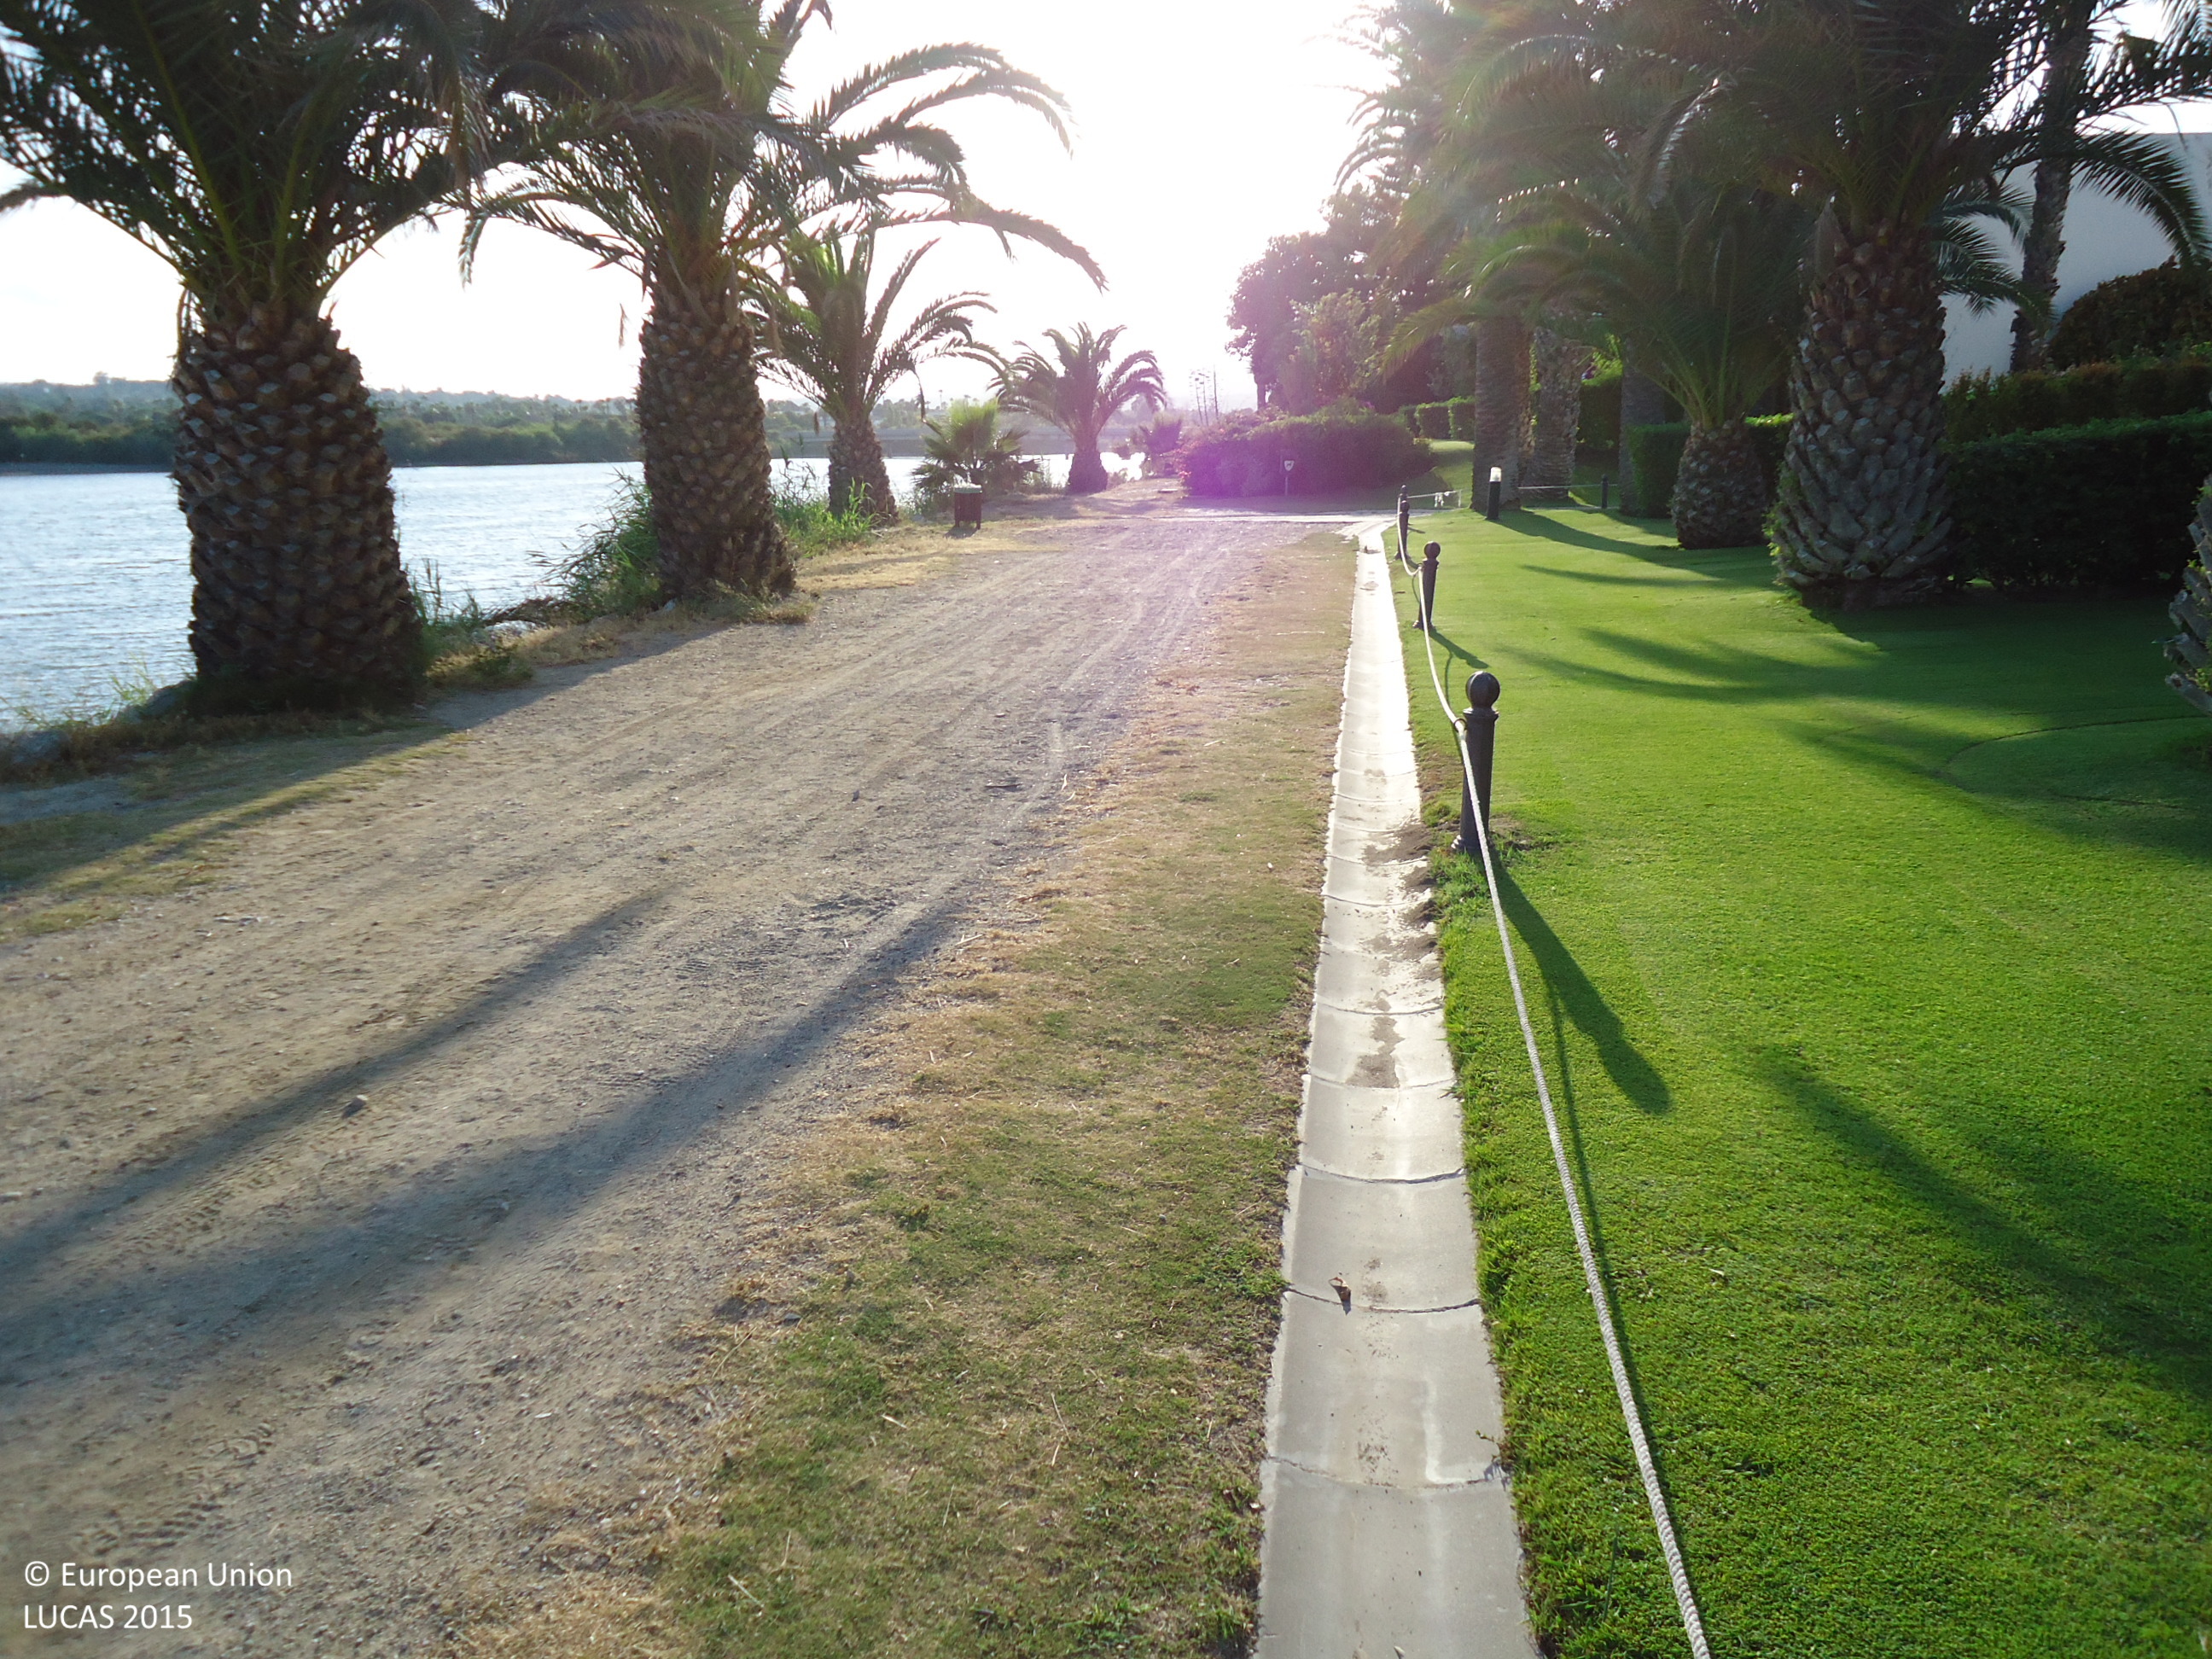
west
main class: Grassland
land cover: Grassland with sparse tree/shrub cover
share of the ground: > 75 %
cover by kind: herbaceous plants 95 %, broadleaved forest trees 5 %
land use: Residential
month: June
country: ES
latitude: 36.2840
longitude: -5.2782
